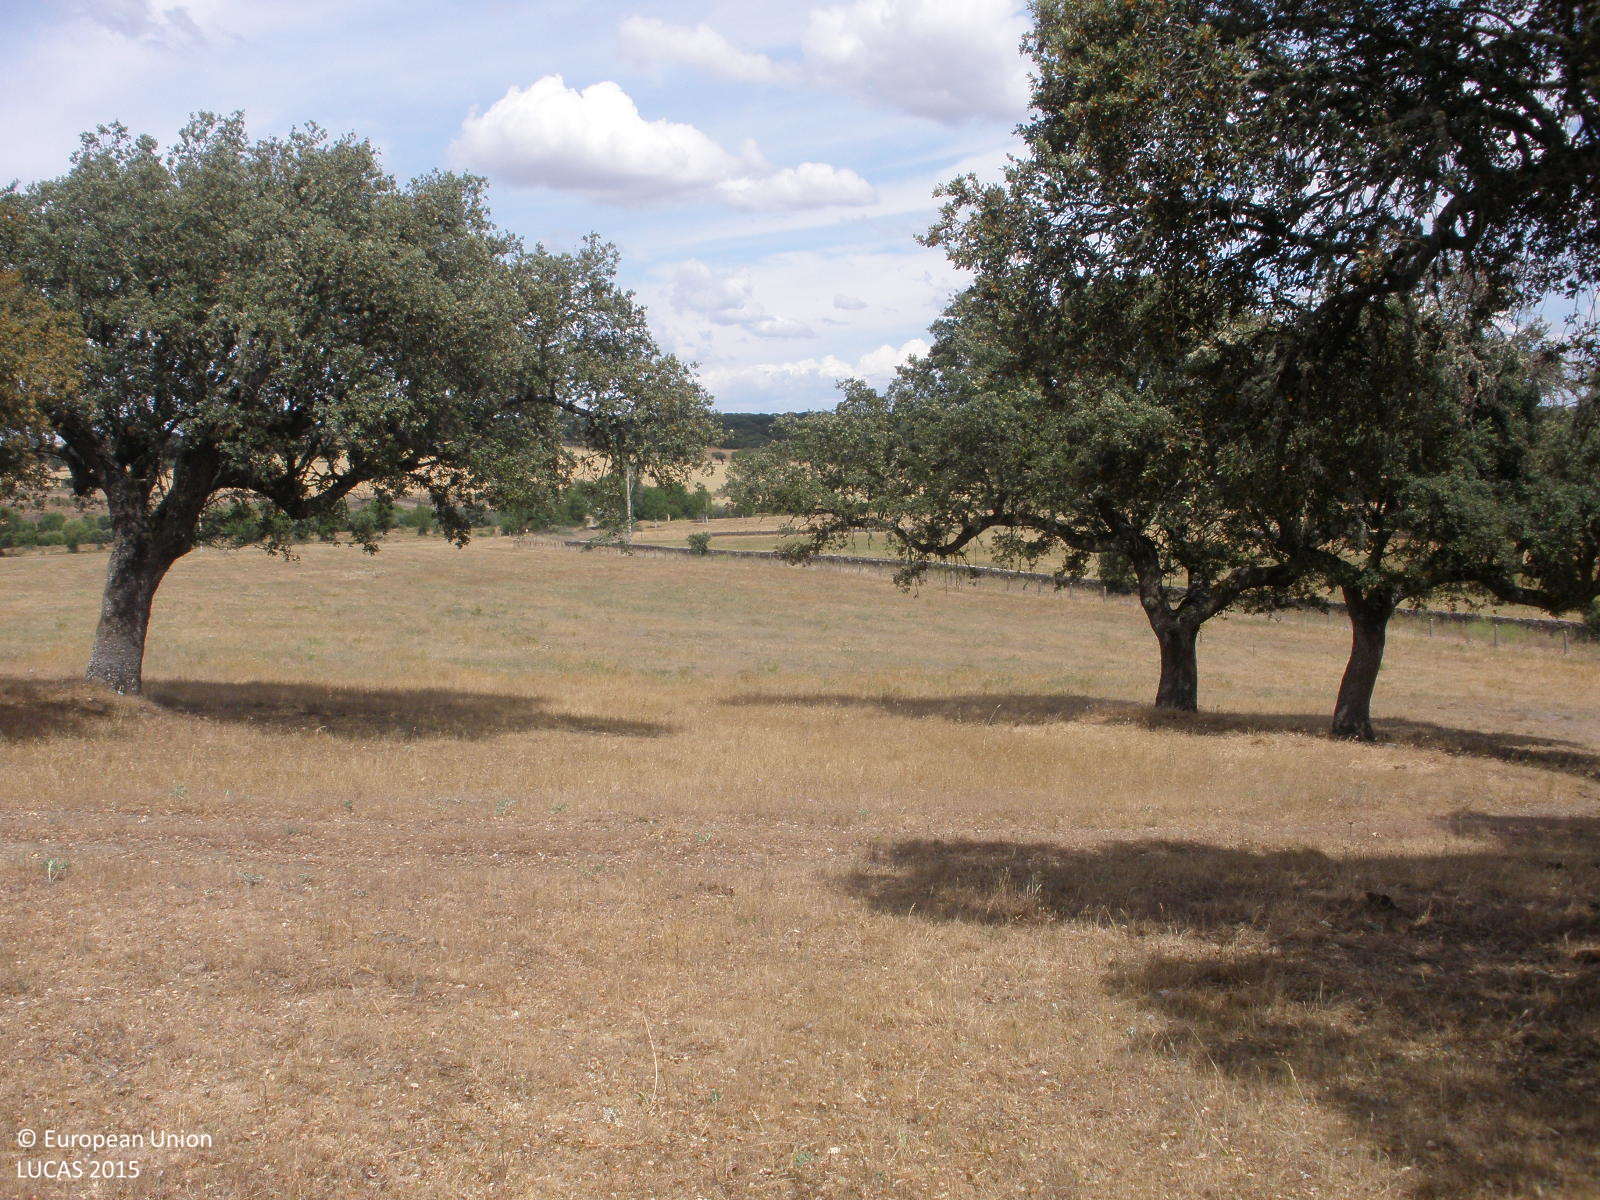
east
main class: Woodland
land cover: Broadleaved woodland
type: broadleaved evergreen forest
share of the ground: 25 - 50 %
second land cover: Grassland without tree/shrub cover
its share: > 75 %
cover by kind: herbaceous plants 60 %, broadleaved forest trees 40 %
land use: Forestry
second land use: Agriculture (excluding fallow land and kitchen gardens)
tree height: > 5 m
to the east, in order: Broadleaved woodland; Grassland without tree/shrub cover; Fences; Tracks; Dry stone walls; Grassland without tree/shrub cover; Electric lines; Grassland without tree/shrub cover
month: June
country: ES
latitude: 40.5804
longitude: -6.6674
